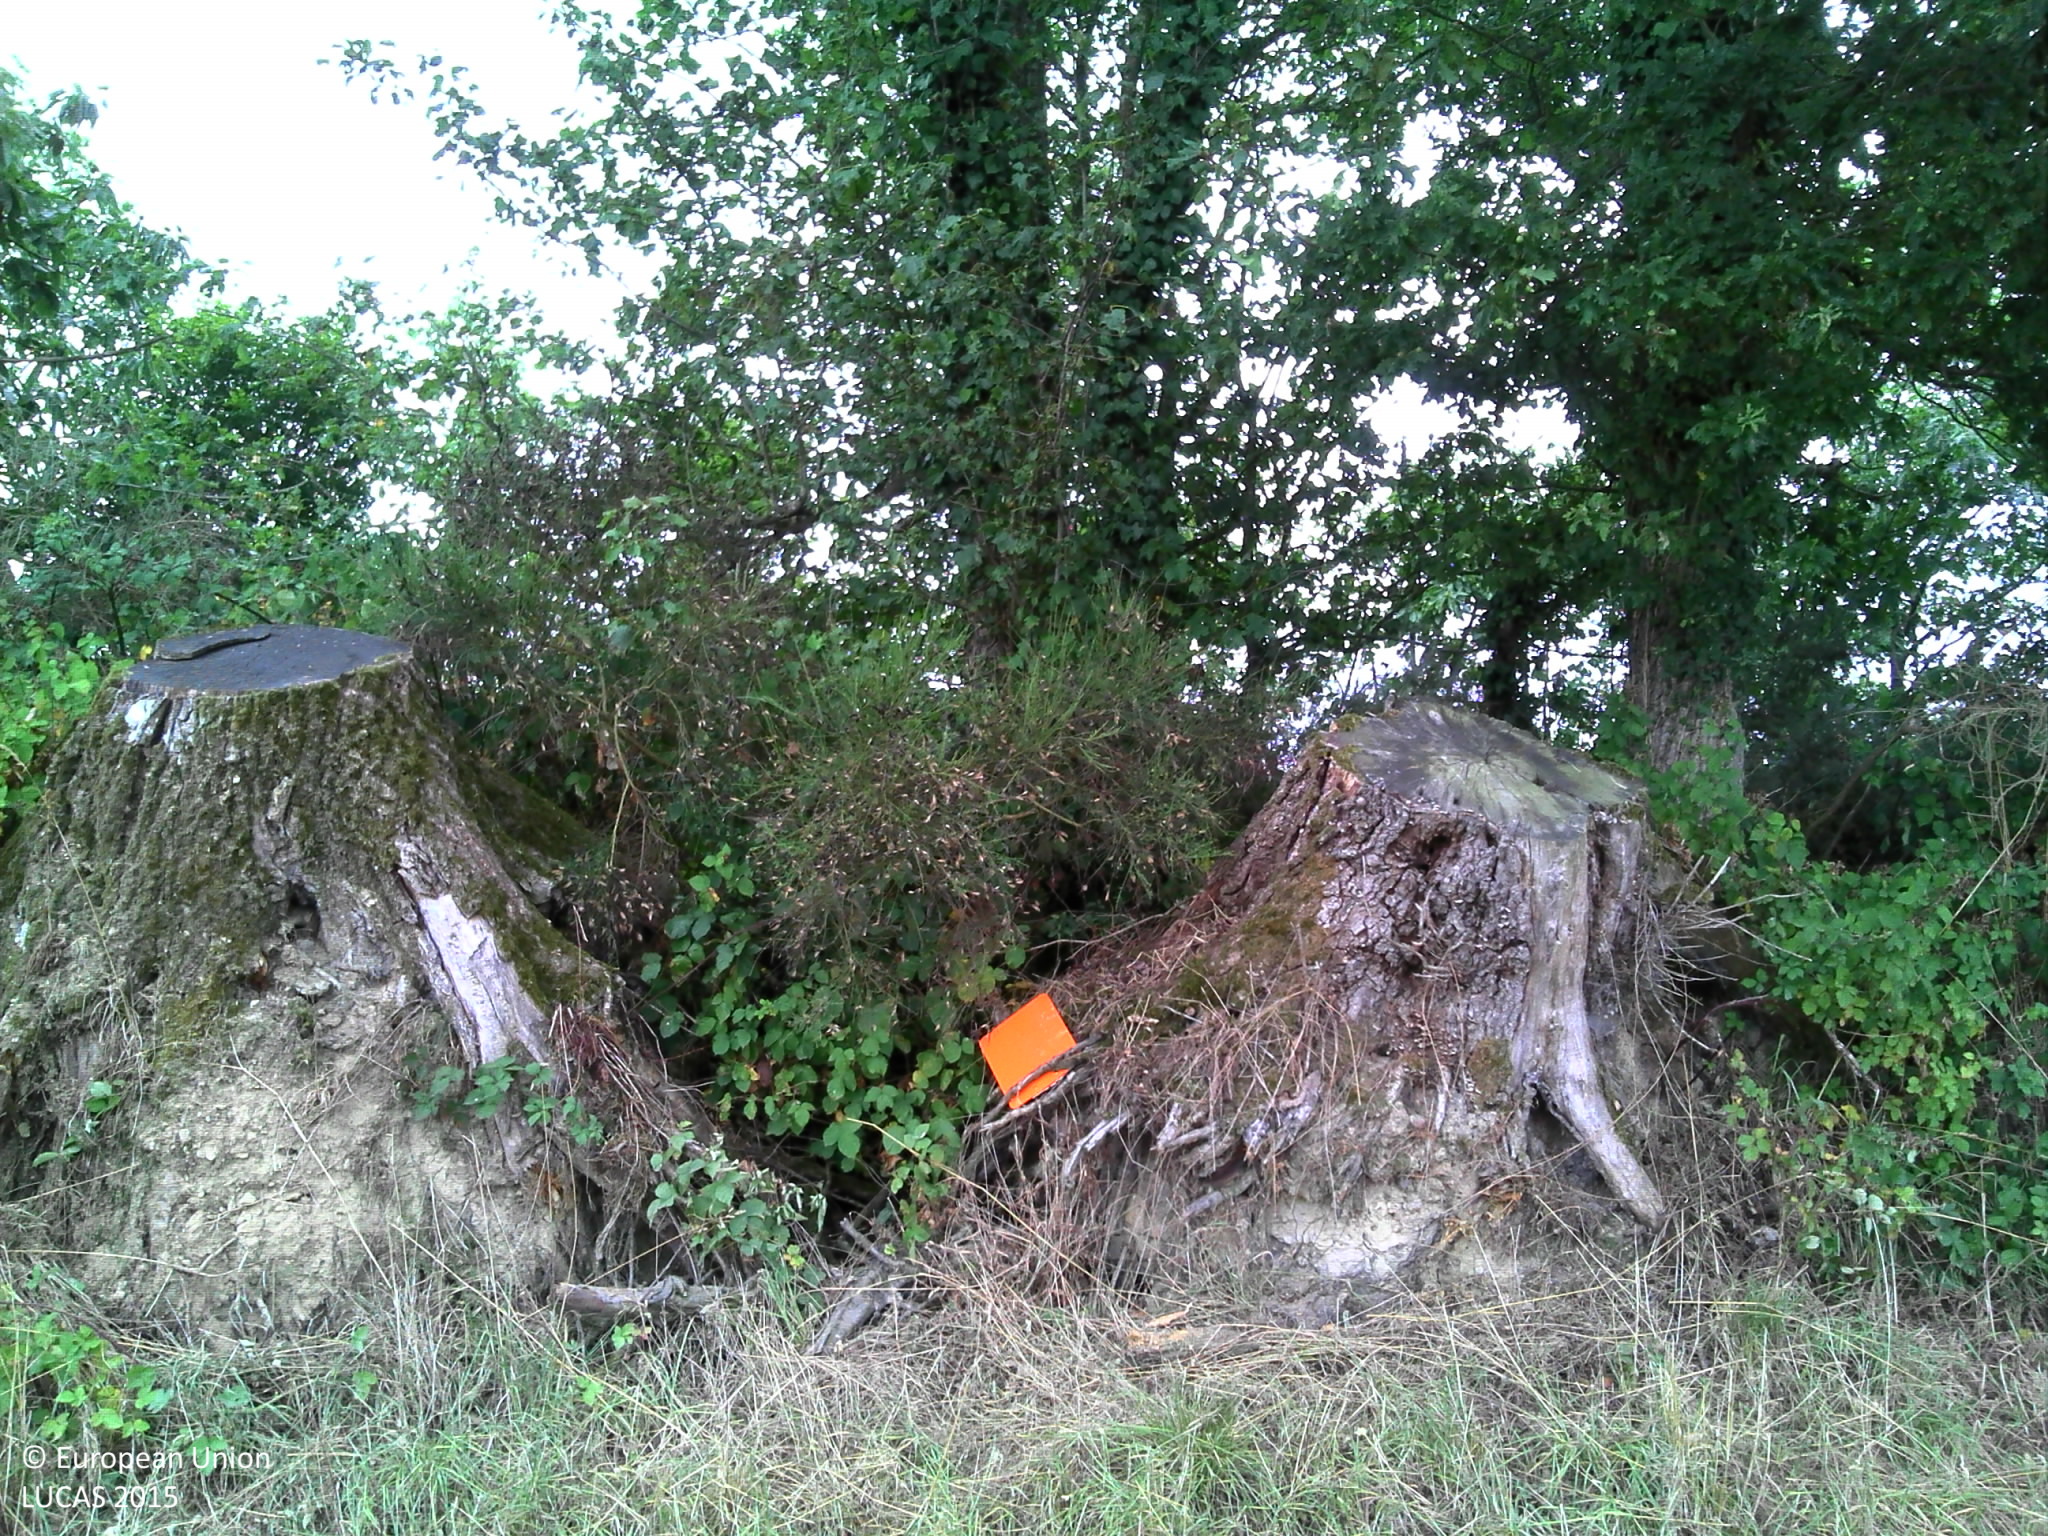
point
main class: Cropland
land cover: Common wheat
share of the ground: > 75 %
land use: Agriculture (excluding fallow land and kitchen gardens)
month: August
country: FR
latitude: 47.8110
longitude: -1.4074
